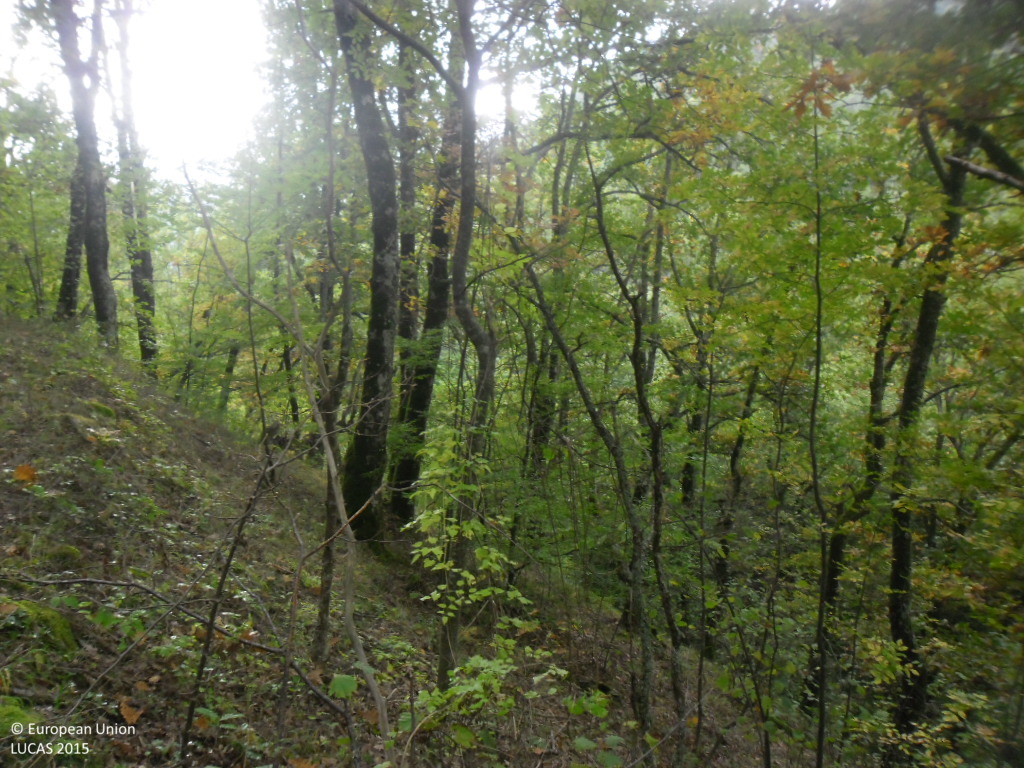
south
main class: Woodland
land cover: Broadleaved woodland
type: mountainous beech forest
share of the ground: > 75 %
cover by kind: broadleaved forest trees 95 %, unconsolidated bare surface 5 %
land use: Forestry
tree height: > 5 m
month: October
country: BG
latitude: 41.6534
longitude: 23.0970
